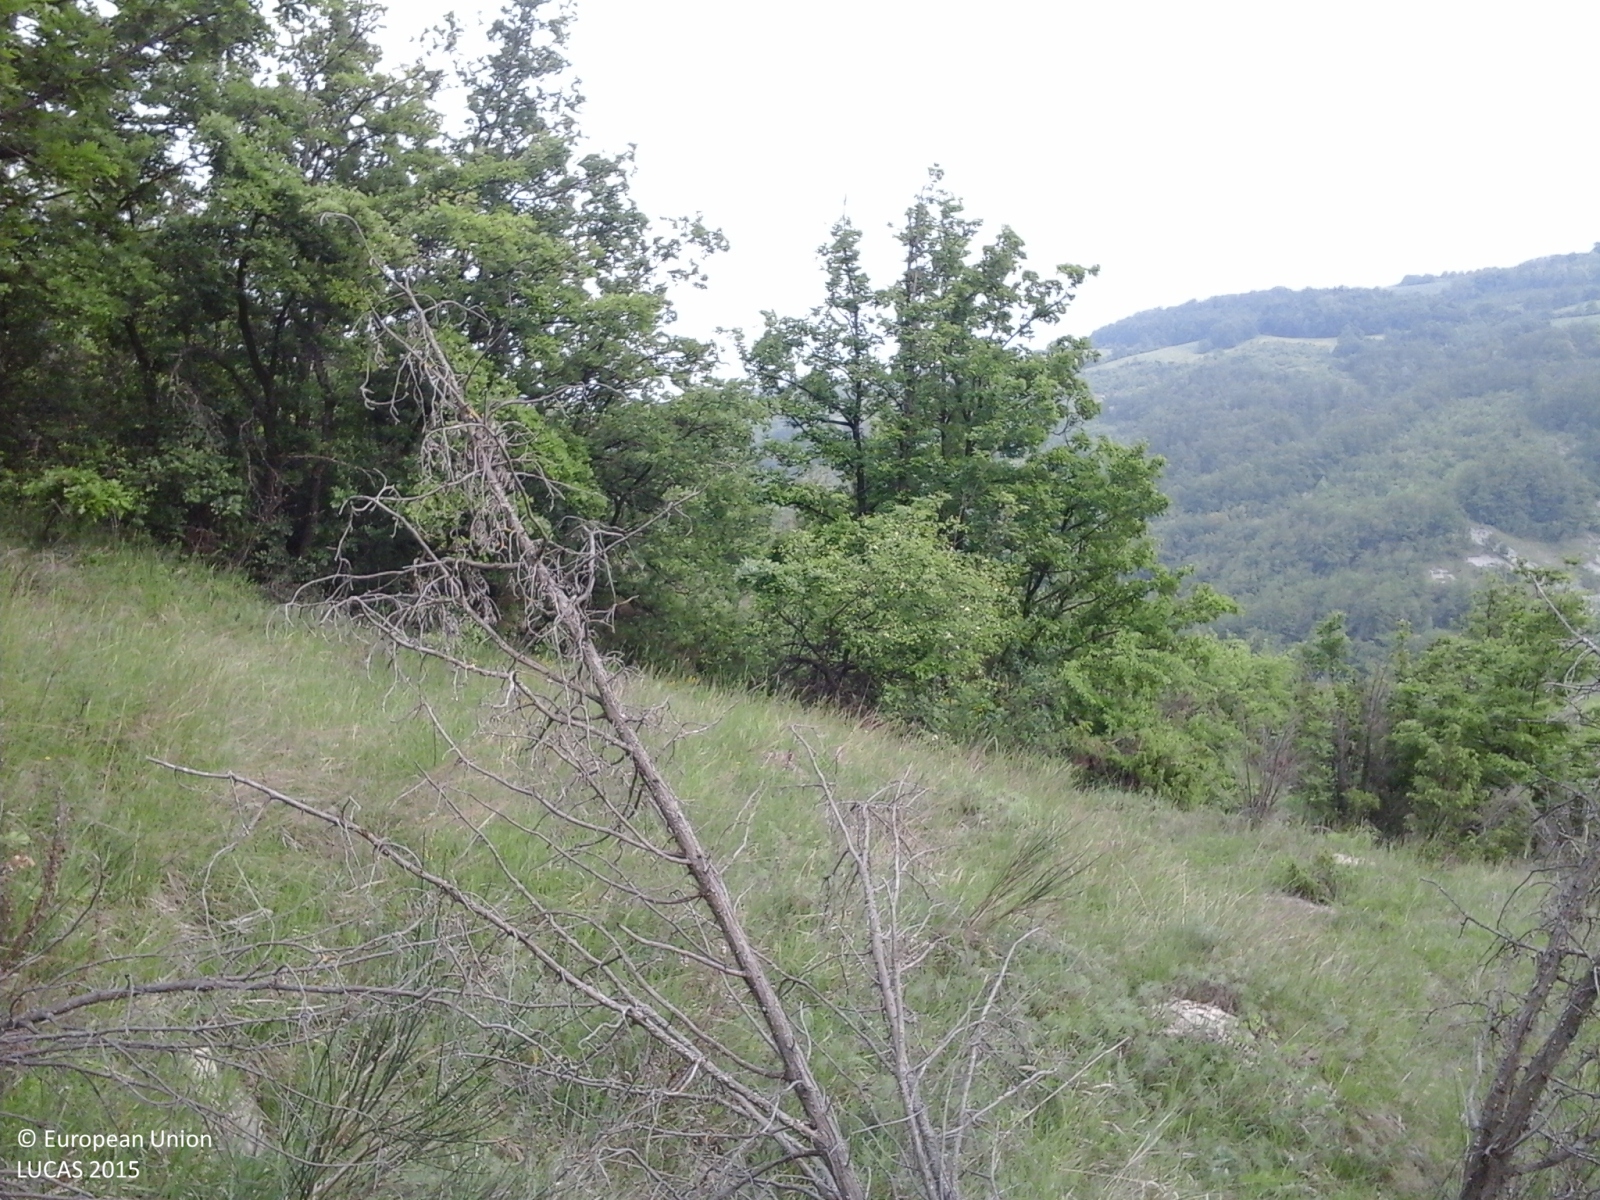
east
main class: Woodland
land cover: Broadleaved woodland
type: mesophytic deciduous forest
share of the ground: 50 - 75 %
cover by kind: broadleaved forest trees 65 %, herbaceous plants 20 %, shrubs 10 %, unconsolidated bare surface 5 %
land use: Semi-natural and natural areas not in use
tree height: > 5 m
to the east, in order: Broadleaved woodland; Tracks; Broadleaved woodland; Paved roads, cycling and walking lanes; Broadleaved woodland; Tracks; Broadleaved woodland
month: May
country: IT
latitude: 44.4189
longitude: 10.8897
